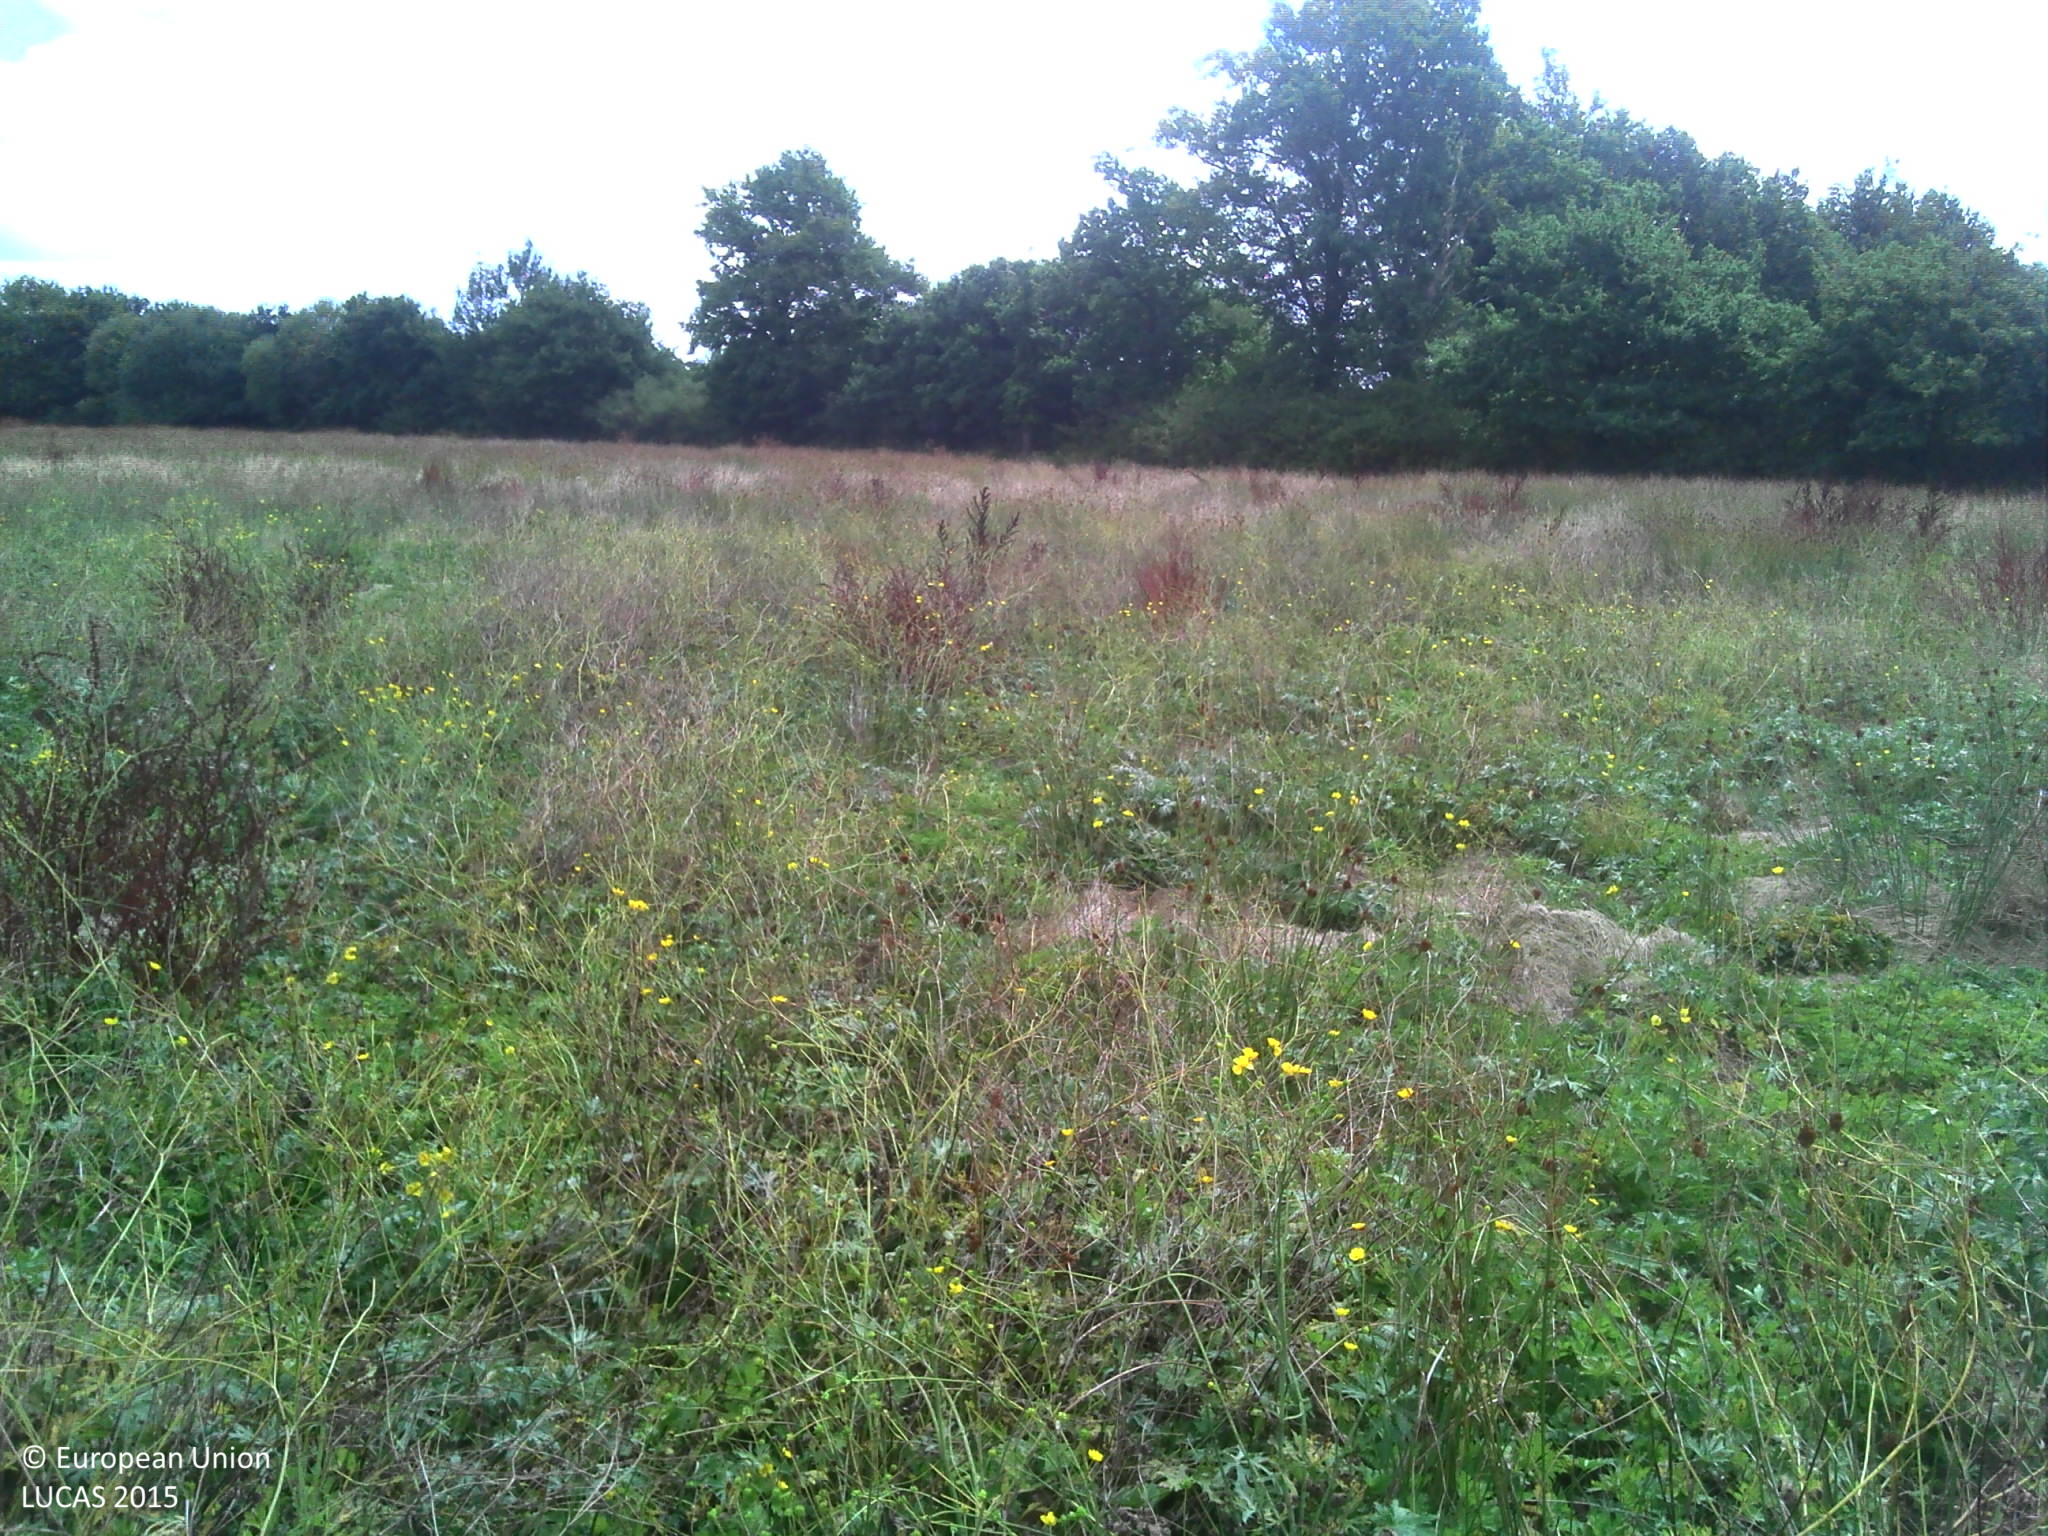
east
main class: Grassland
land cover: Grassland without tree/shrub cover
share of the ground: > 75 %
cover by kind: herbaceous plants 100 %
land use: Agriculture (excluding fallow land and kitchen gardens)
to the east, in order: Fences; Grassland without tree/shrub cover; Broadleaved woodland; Ditches and canals; Grassland without tree/shrub cover; Broadleaved woodland; Ditches and canals; Electric lines; Railways; Electric lines; Abandoned hedges; Artificial constructions in urban areas
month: August
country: FR
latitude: 46.7356
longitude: -1.4369
